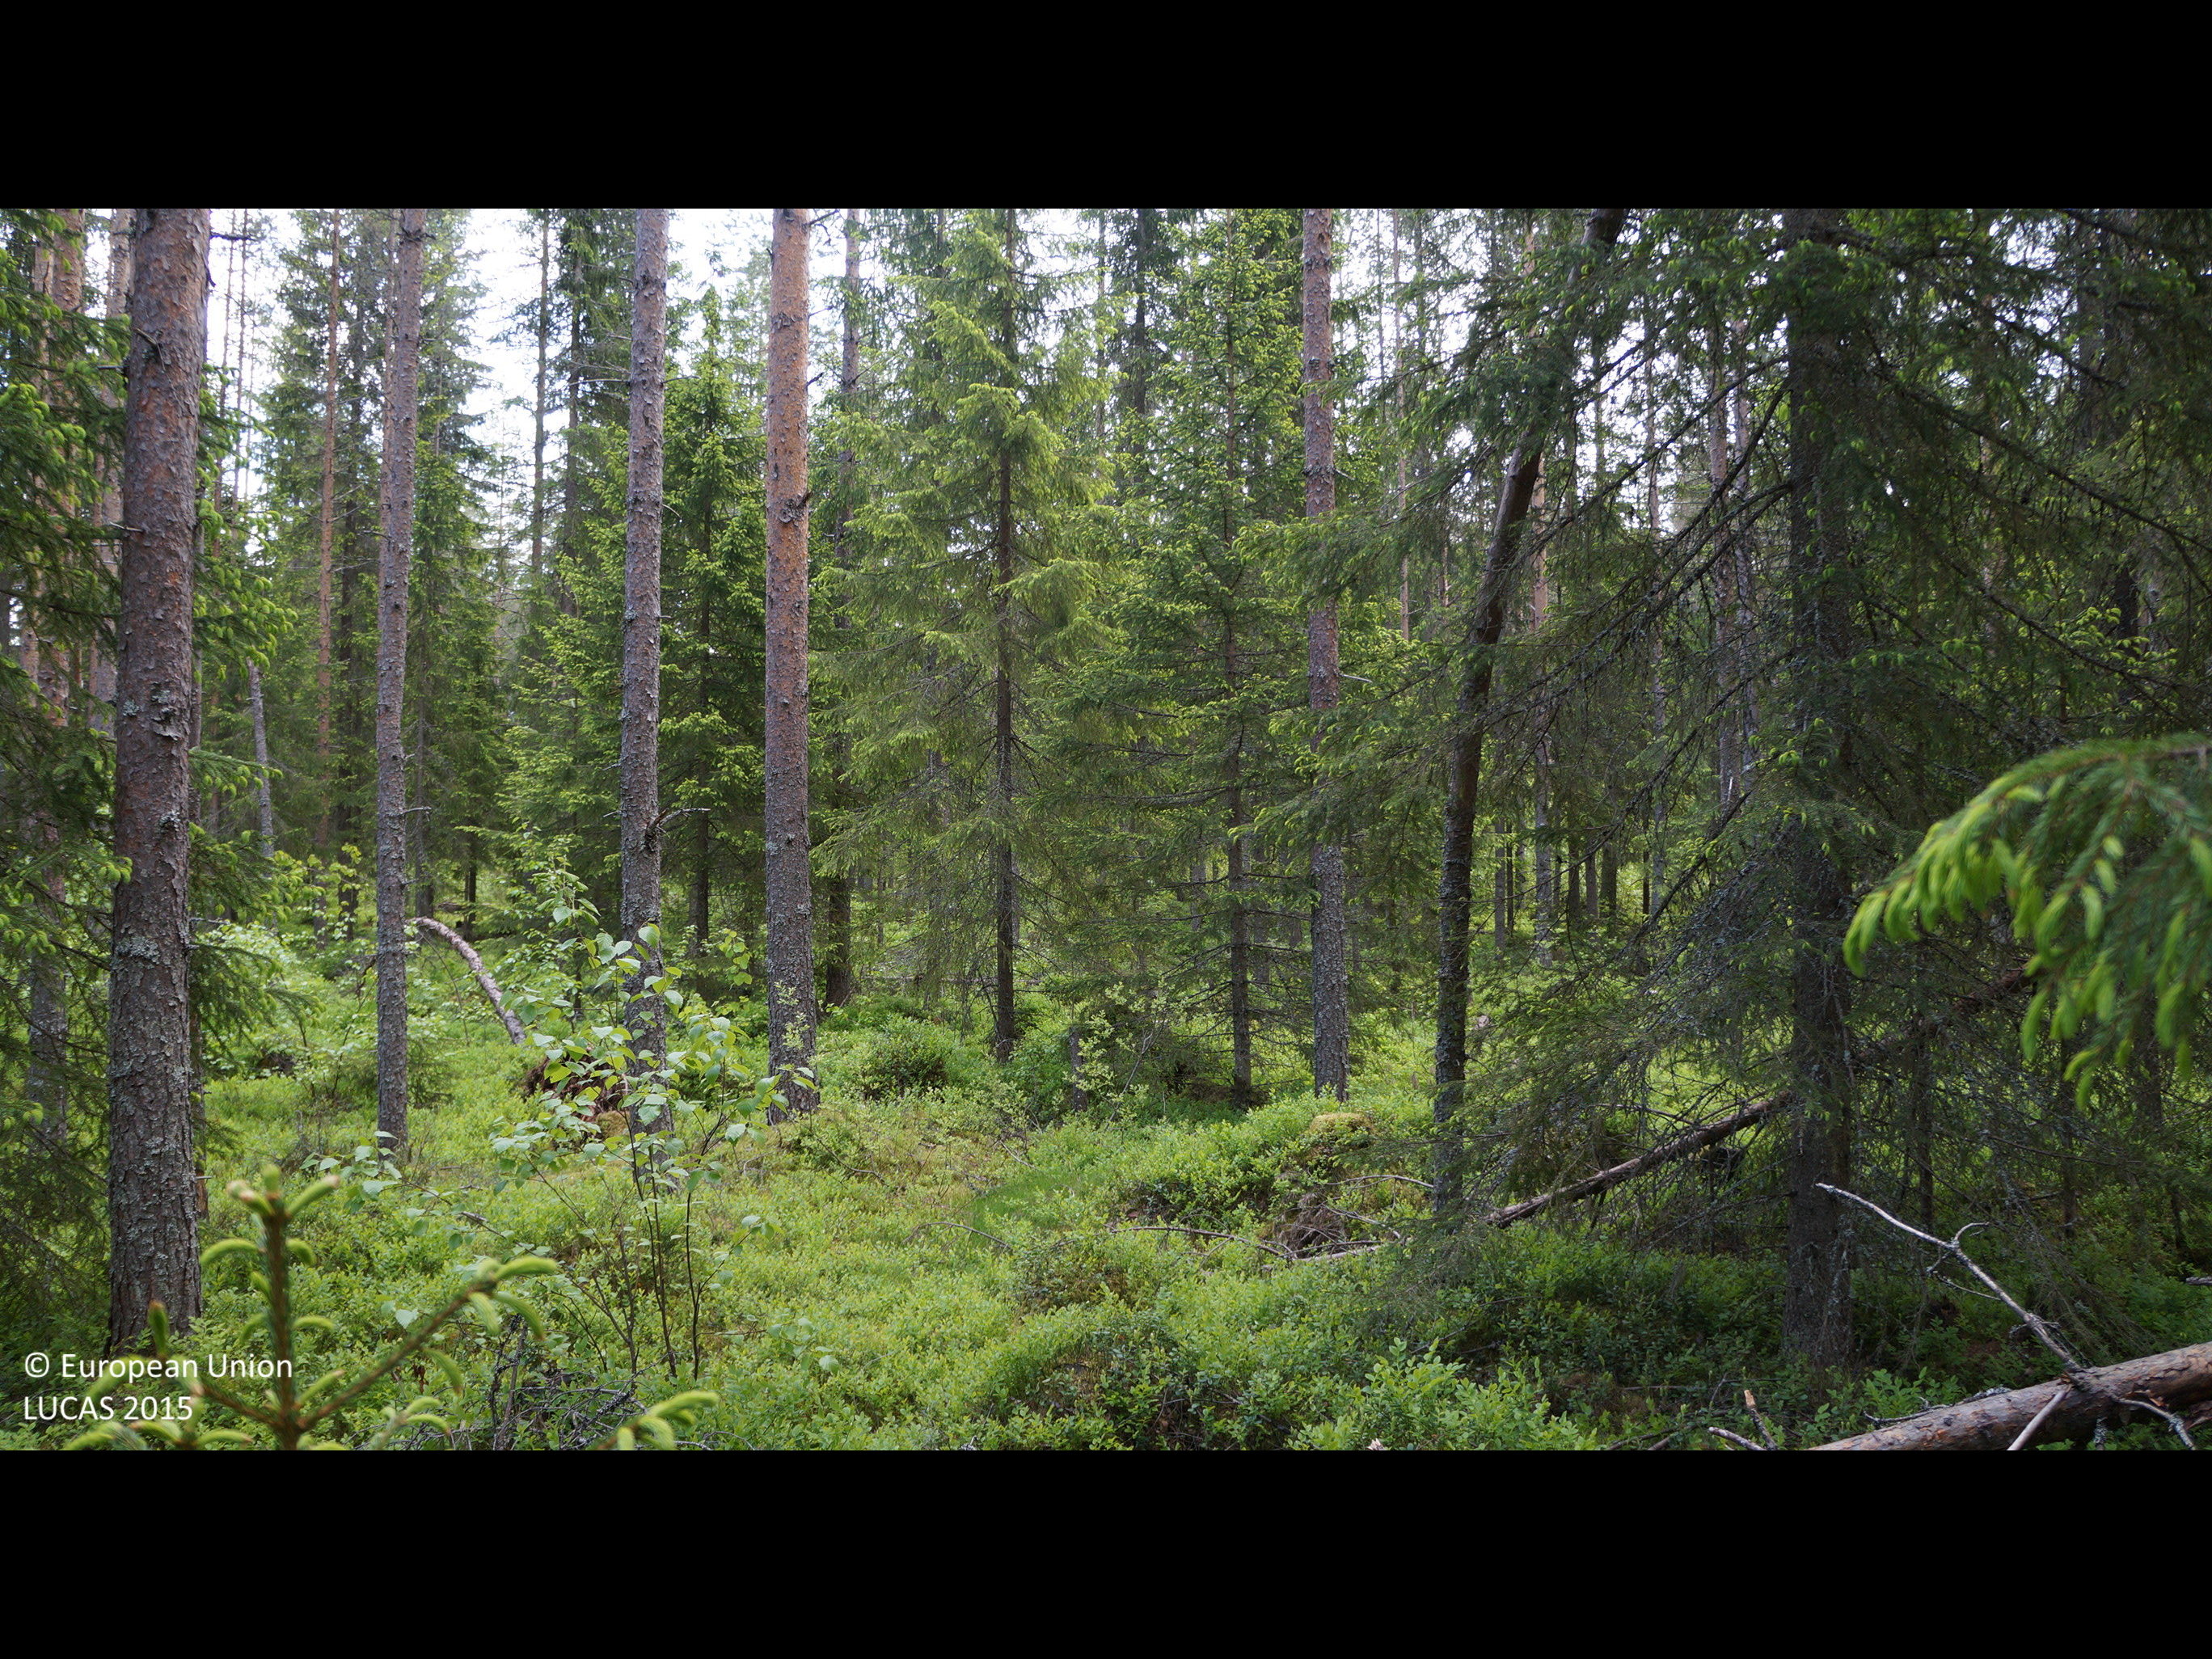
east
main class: Woodland
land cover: Pine dominated coniferous woodland
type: boreal forest
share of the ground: > 75 %
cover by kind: coniferous forest trees 70 %, shrubs 15 %, lichens and mosses 15 %
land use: Forestry
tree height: > 5 m
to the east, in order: Pine dominated coniferous woodland; Spruce dominated coniferous woodland; Broadleaved woodland; Spruce dominated coniferous woodland; Ditches and canals; Spruce dominated coniferous woodland; Broadleaved woodland; Pine dominated mixed woodland; Ditches and canals; Pine dominated mixed woodland; Broadleaved woodland; Tracks; Broadleaved woodland; Ditches and canals; Pine dominated mixed woodland
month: June
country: FI
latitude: 64.1720
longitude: 25.2500
